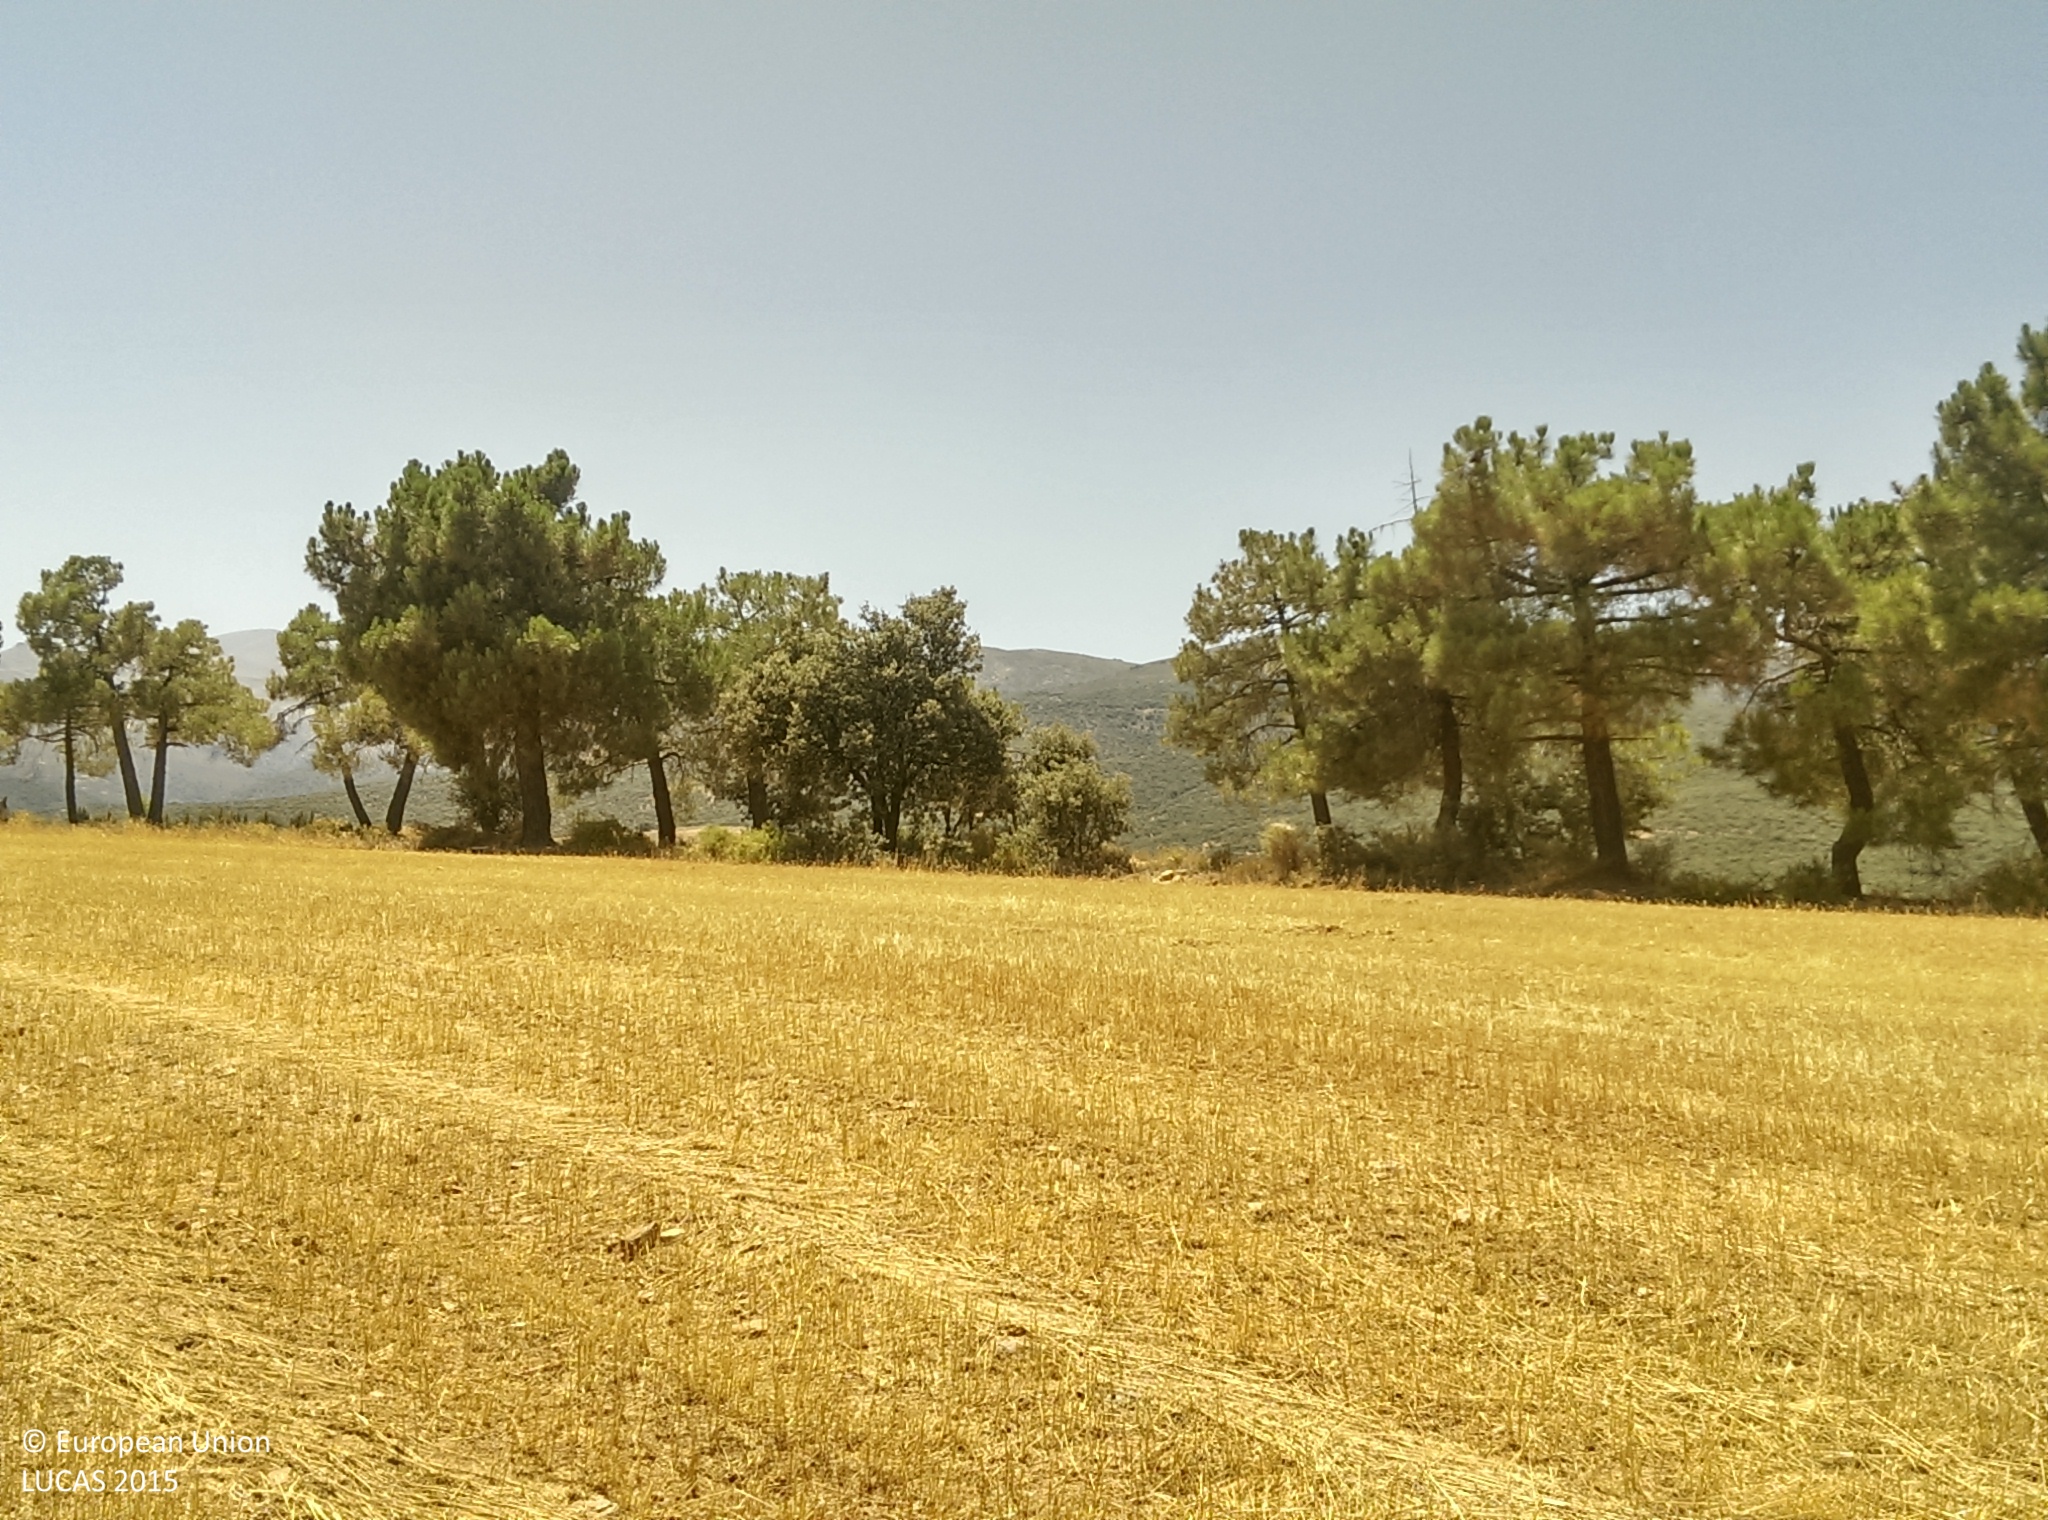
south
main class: Cropland
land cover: Oats
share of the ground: < 10 %
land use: Agriculture (excluding fallow land and kitchen gardens)
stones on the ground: 25 - 50 %
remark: Harvested field
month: July
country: ES
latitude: 37.2374
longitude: -3.2544
